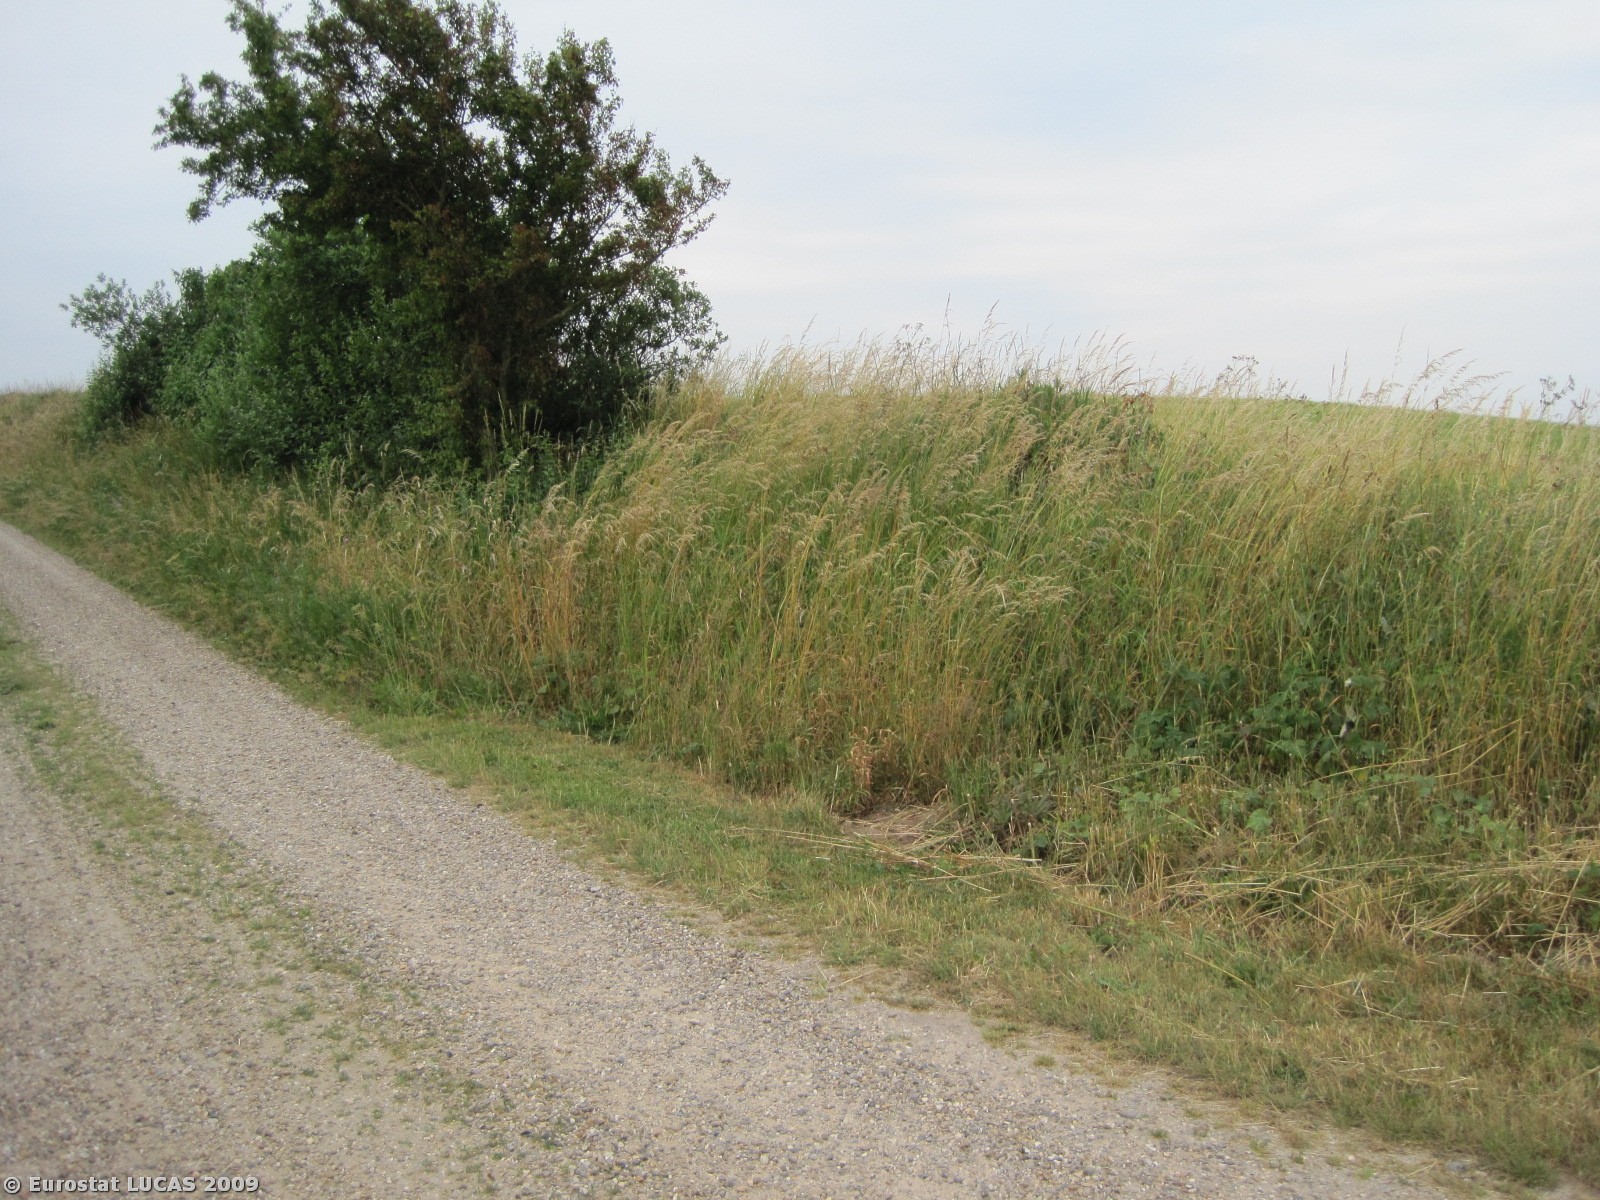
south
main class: Cropland
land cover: Rape and turnip rape
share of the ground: > 75 %
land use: Agriculture (excluding fallow land and kitchen gardens)
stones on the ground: 25 - 50 %
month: June
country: DK
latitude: 56.5029
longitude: 8.5234
